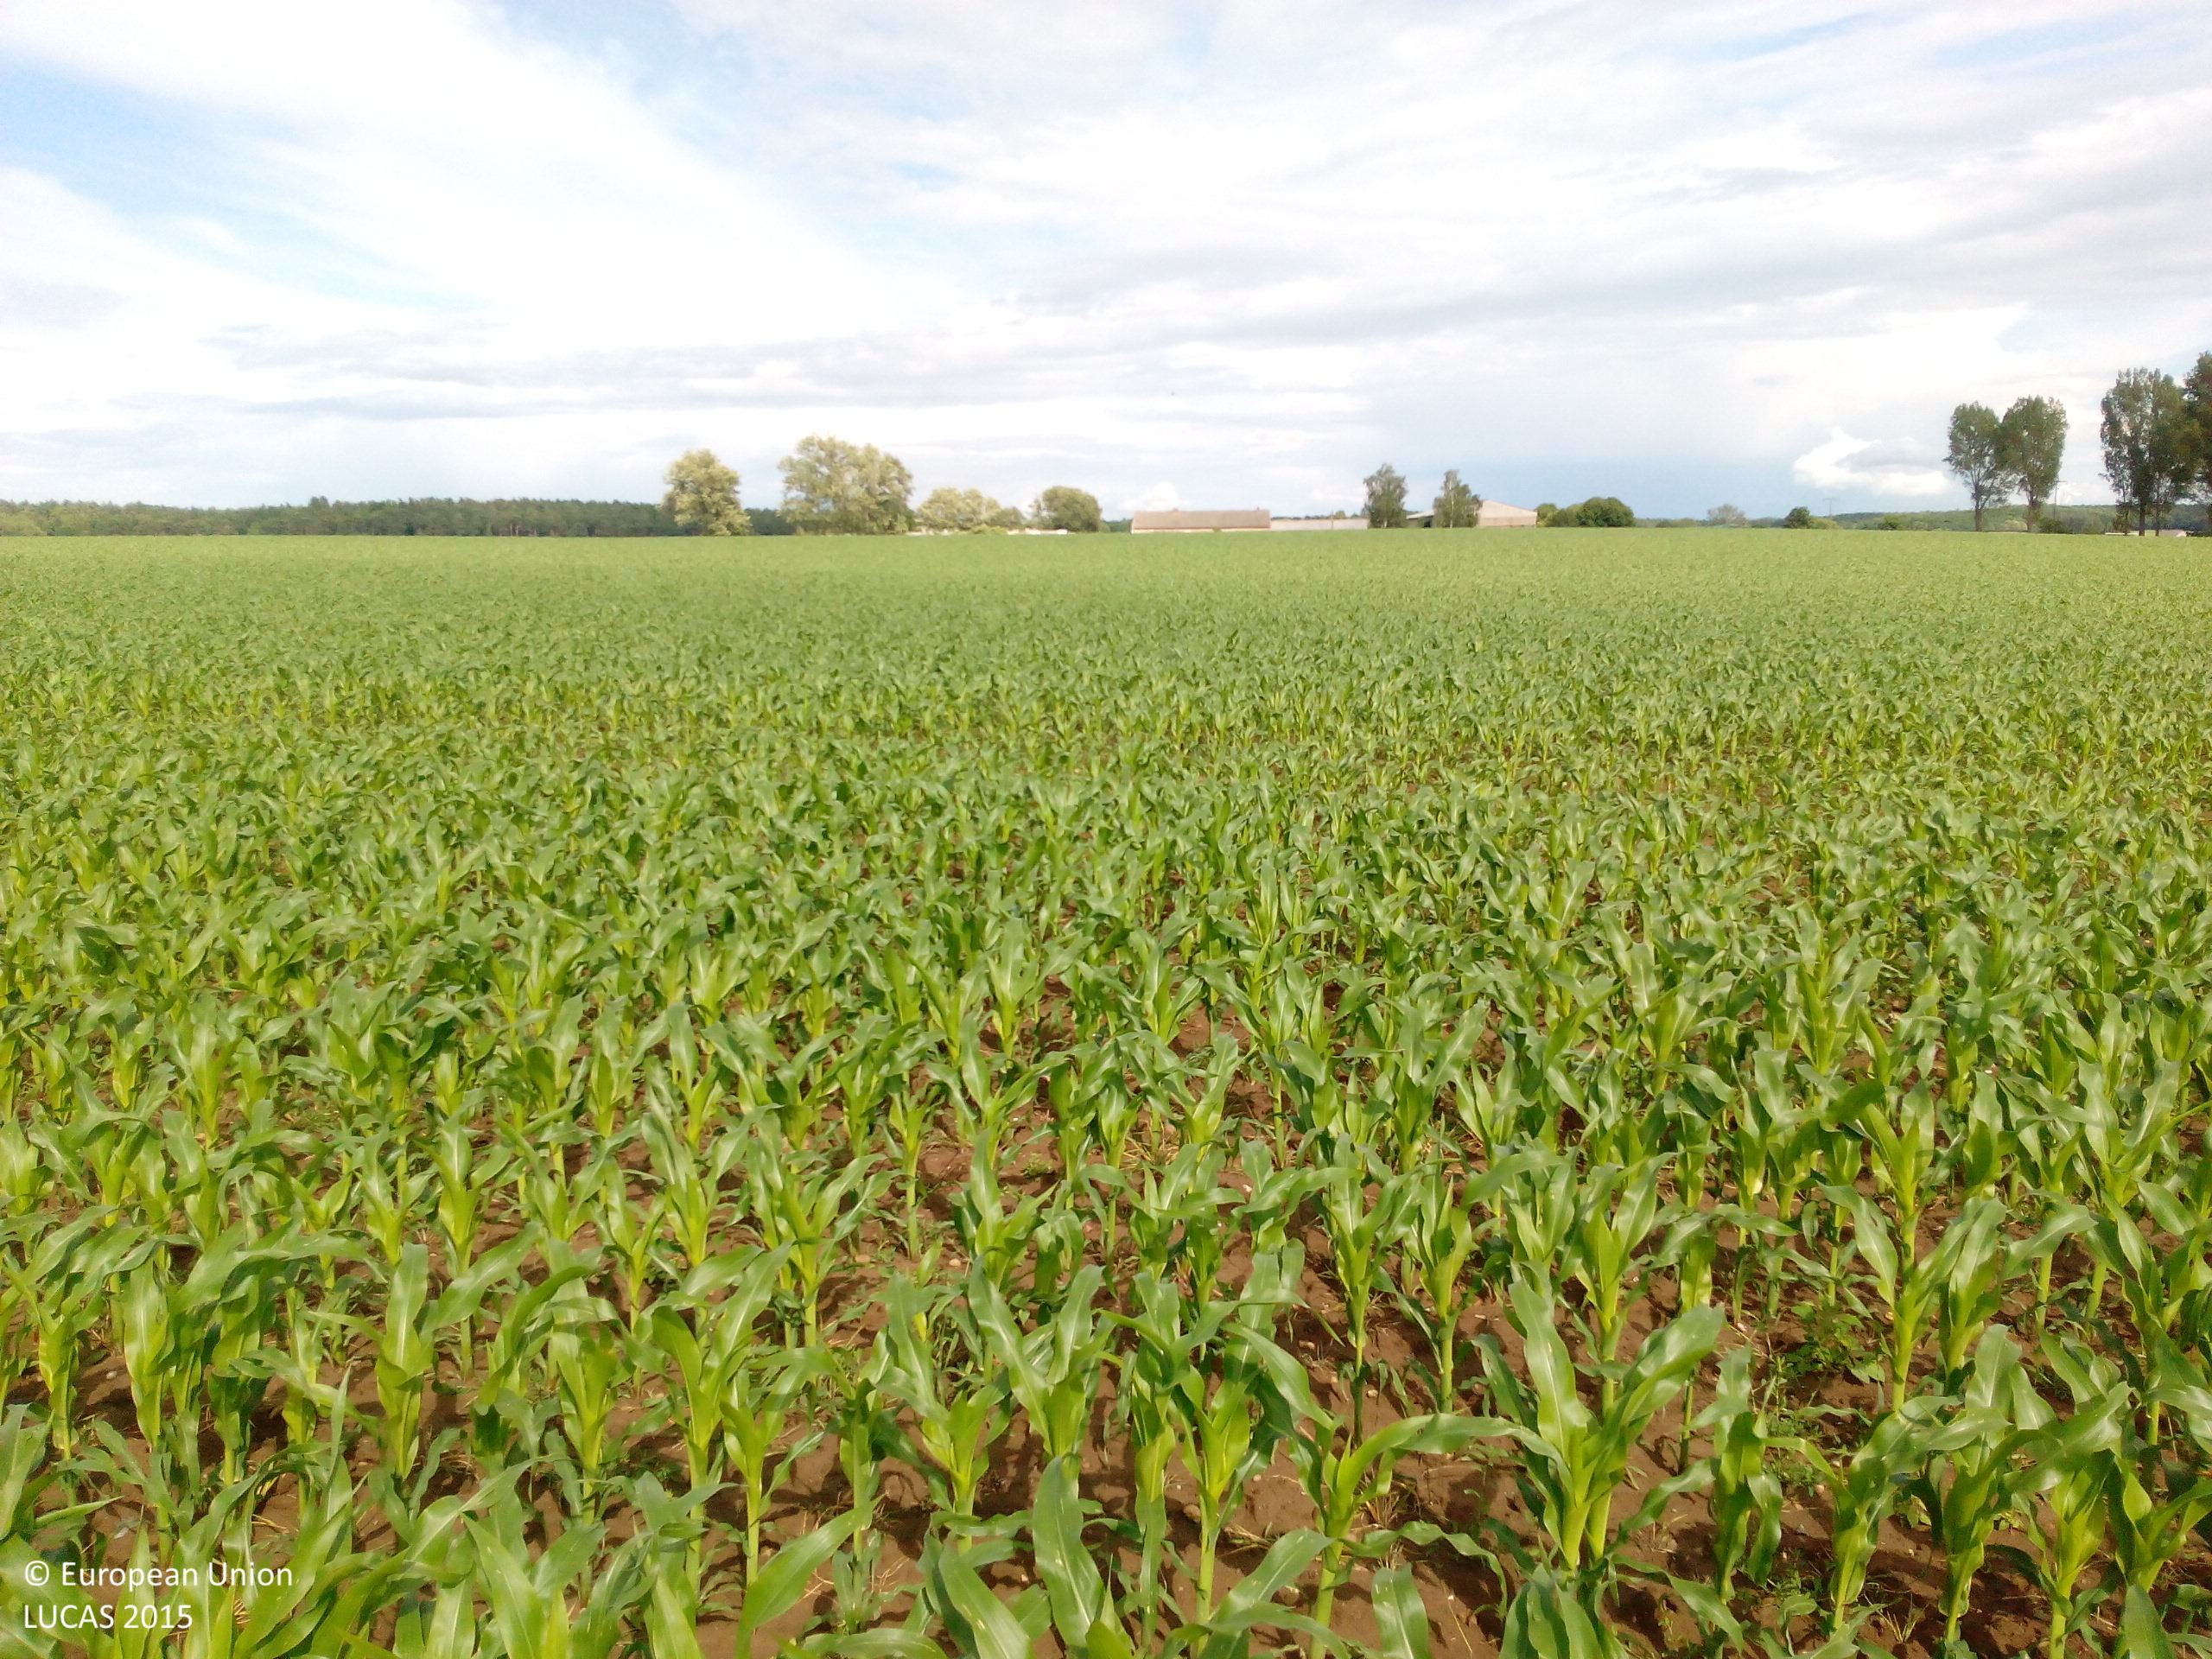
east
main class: Cropland
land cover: Maize
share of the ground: 10 - 25 %
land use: Agriculture (excluding fallow land and kitchen gardens)
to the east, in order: Maize
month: June
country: DE
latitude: 52.2463
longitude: 11.1274
